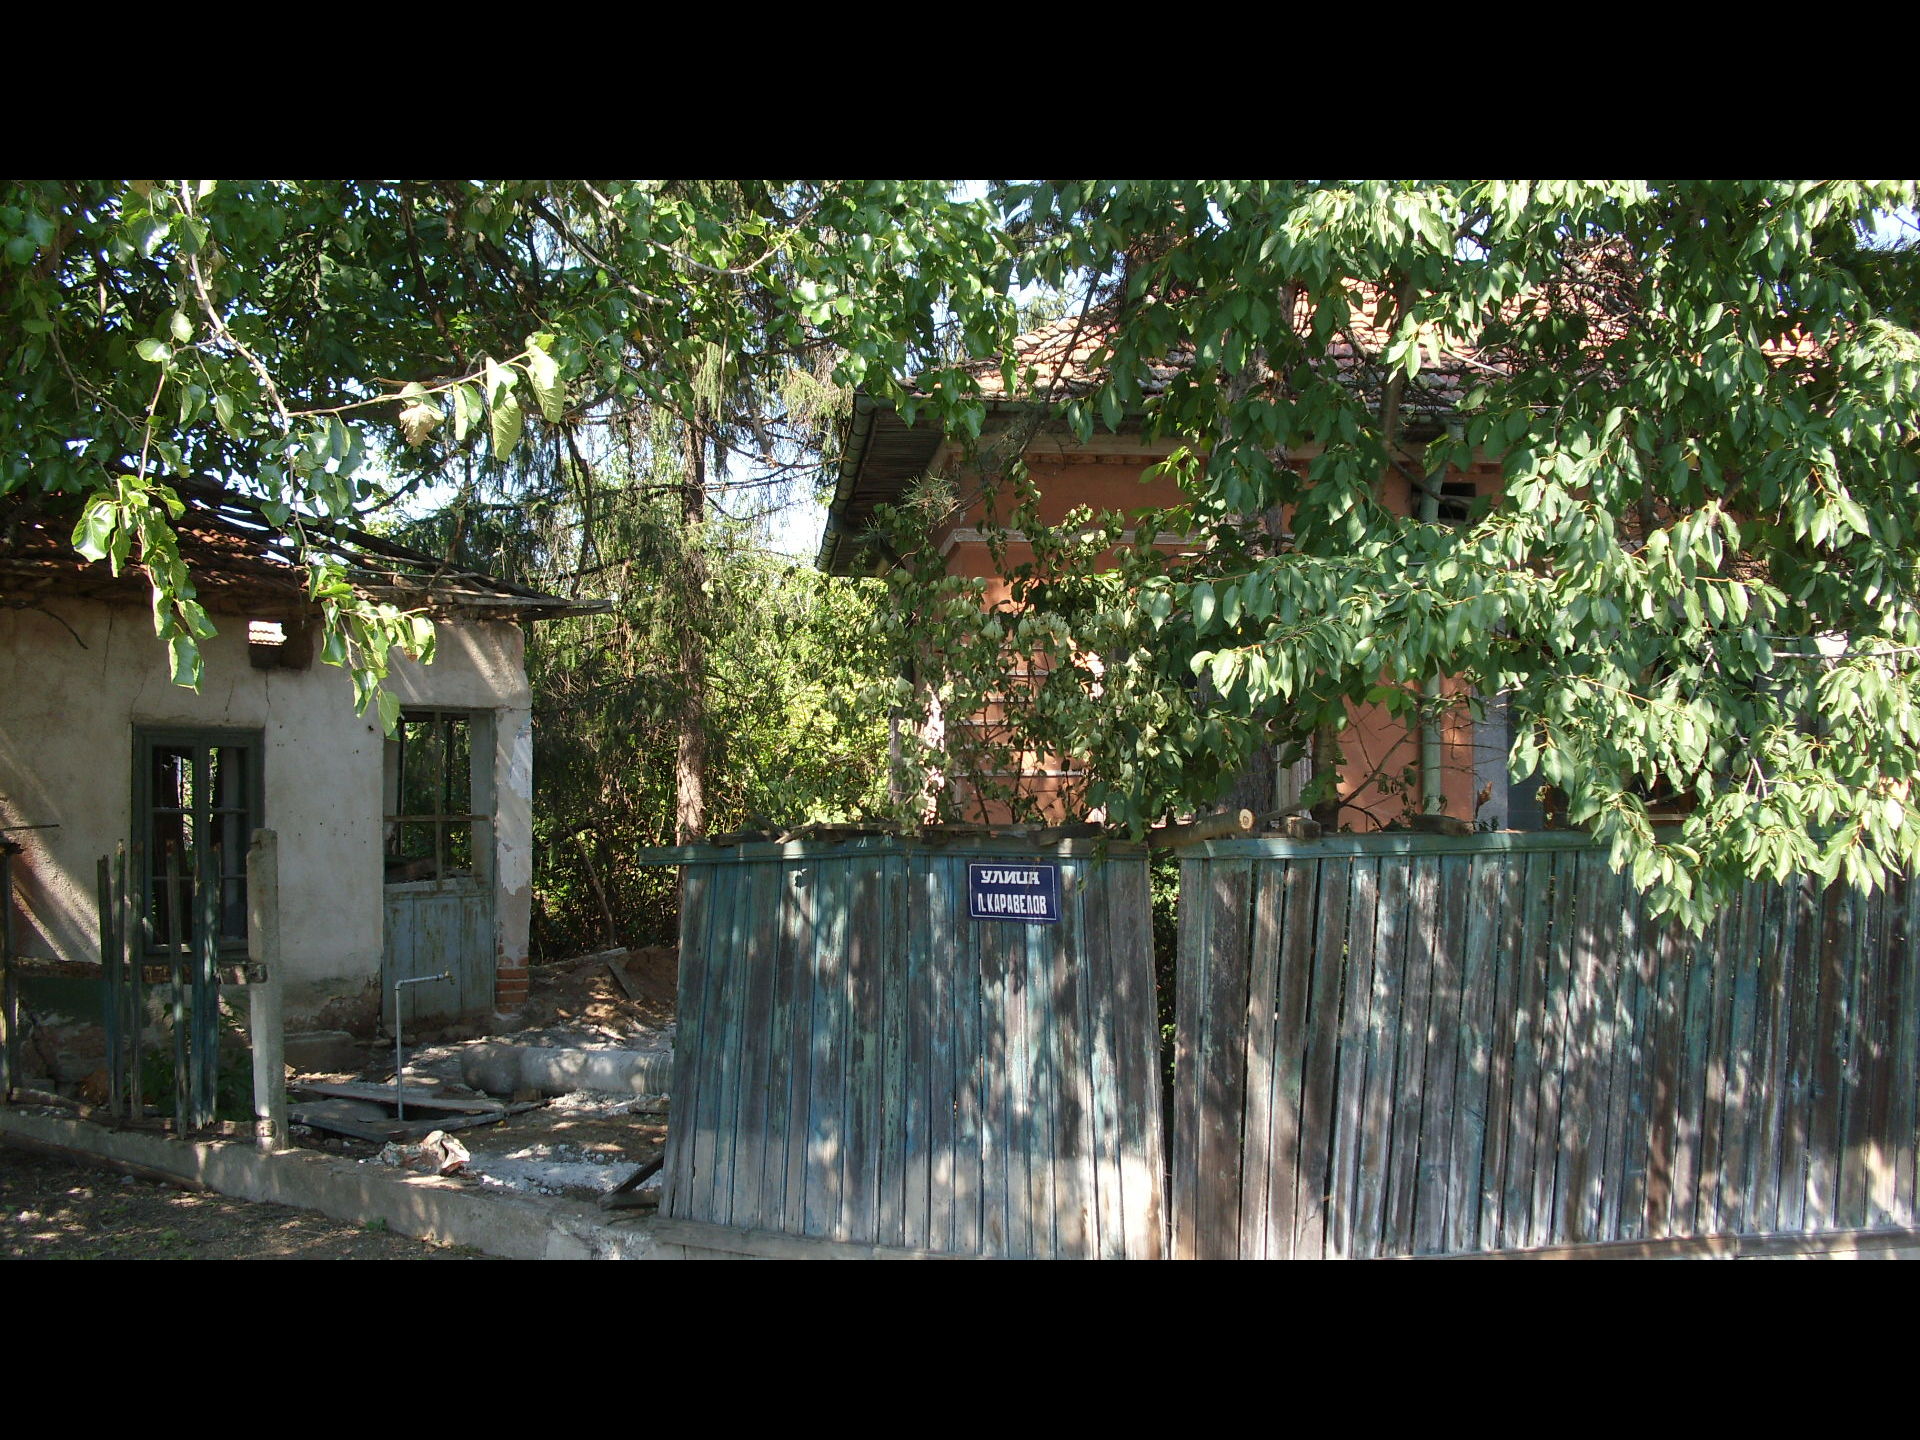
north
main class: Grassland
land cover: Grassland with sparse tree/shrub cover
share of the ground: > 75 %
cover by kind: herbaceous plants 90 %, broadleaved forest trees 5 %, shrubs 5 %
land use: Residential
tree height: > 5 m
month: August
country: BG
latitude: 44.1206
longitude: 22.6461
